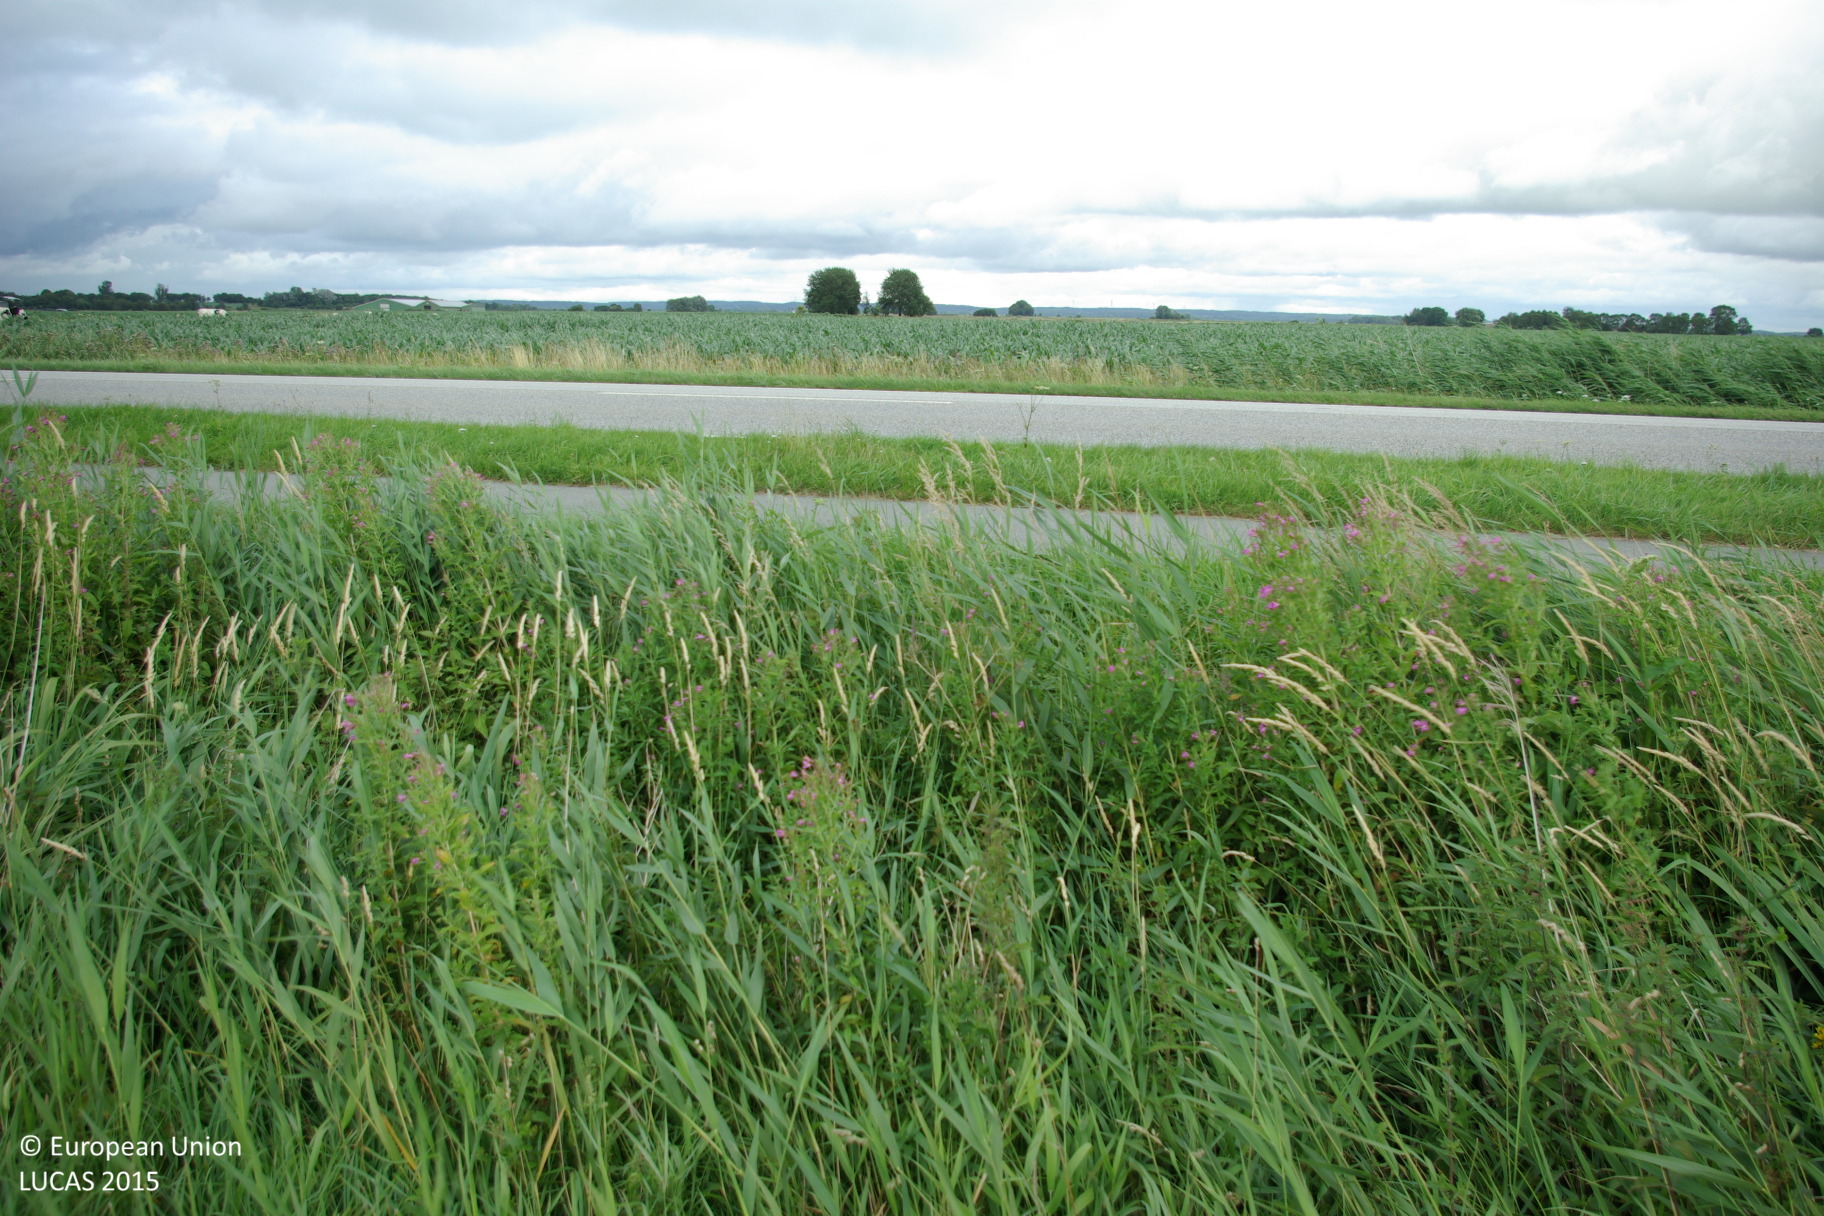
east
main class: Grassland
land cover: Grassland without tree/shrub cover
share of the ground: > 75 %
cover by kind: herbaceous plants 100 %
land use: Agriculture (excluding fallow land and kitchen gardens)
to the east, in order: Grassland without tree/shrub cover; Ditches and canals; Ponds and wetlands; Shruby margins; Paved roads, cycling and walking lanes; Grass margins; Paved roads, cycling and walking lanes; Grassland without tree/shrub cover; Shruby margins; Ditches and canals; Ponds and wetlands; Grass margins; Maize; Spontaneously vegetated surfaces; Ditches and canals; Spontaneously vegetated surfaces; Fences; Grassland without tree/shrub cover; Fences; Ditches and canals; Fences; Grassland without tree/shrub cover
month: July
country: DE
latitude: 54.1352
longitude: 9.0669
